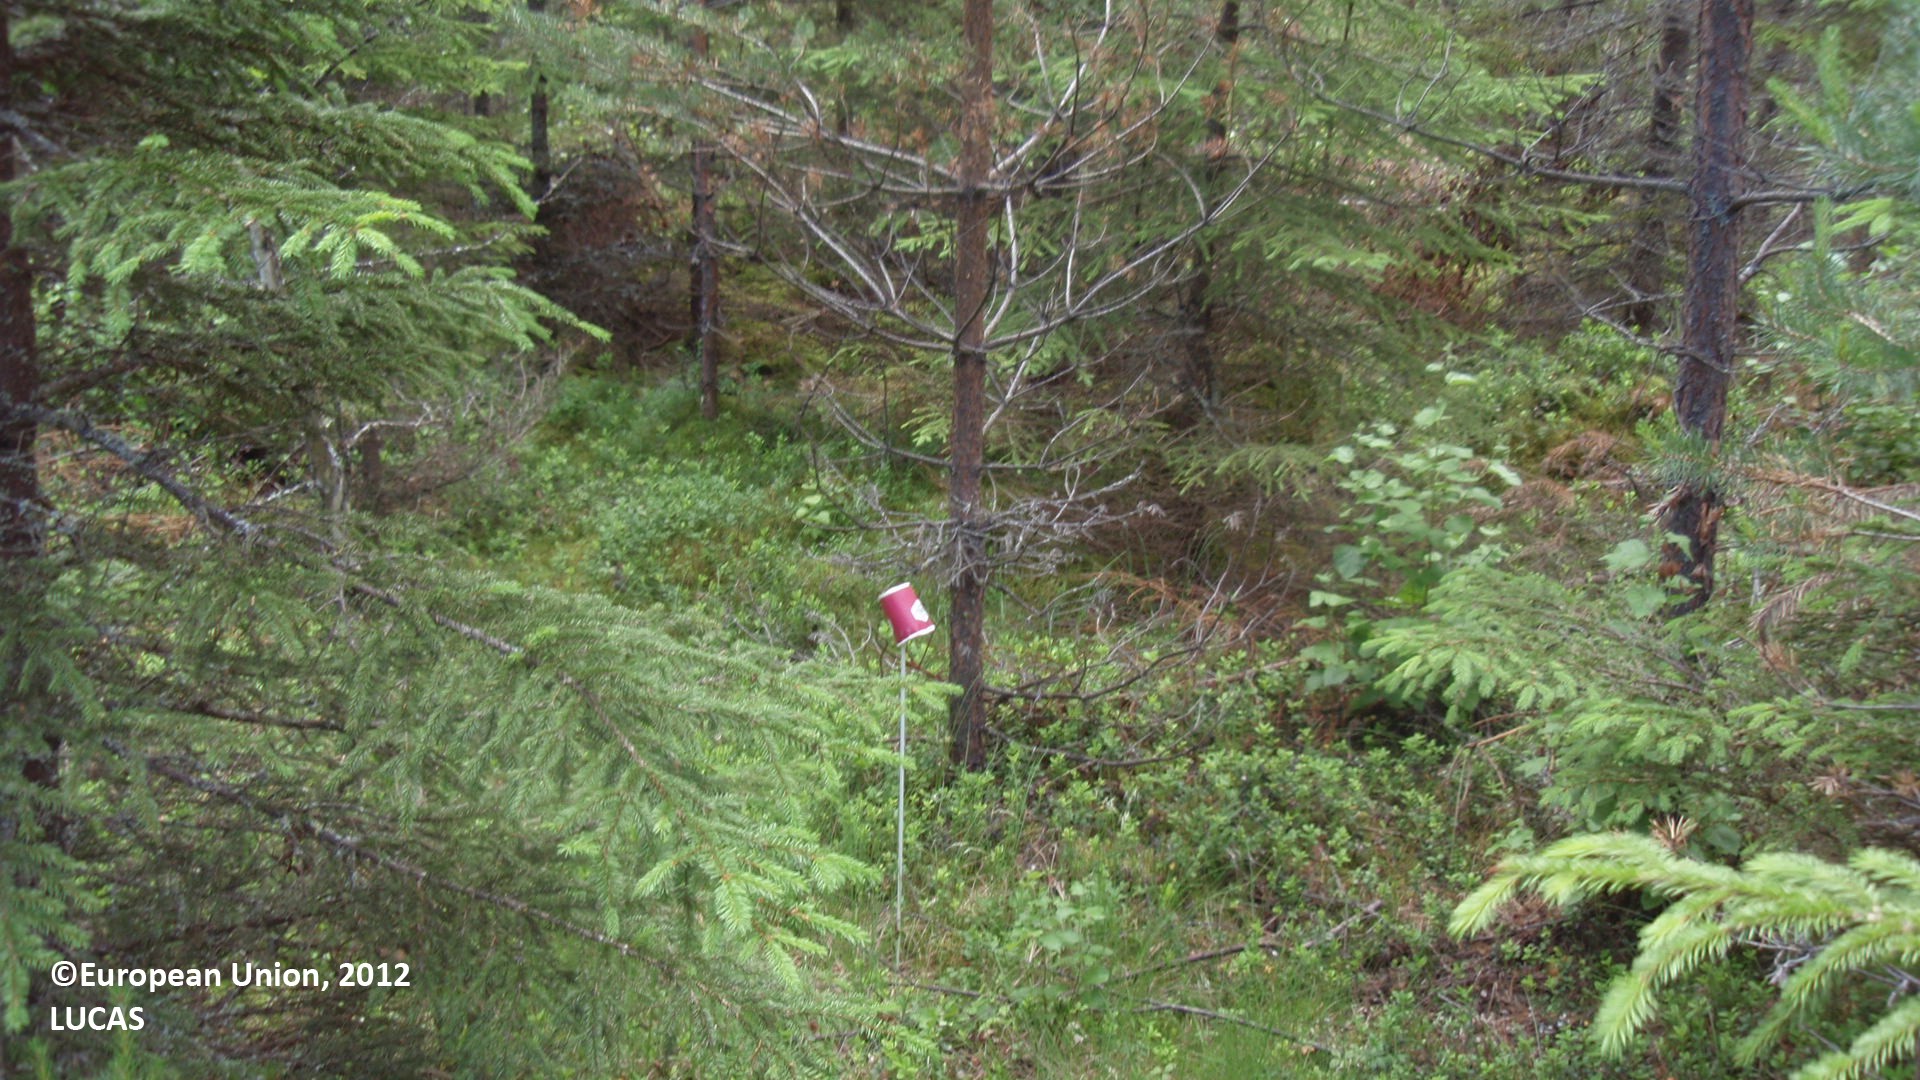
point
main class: Woodland
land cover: Spruce dominated coniferous woodland
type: boreal forest
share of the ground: 50 - 75 %
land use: Forestry
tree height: < 5 m
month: July
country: FI
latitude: 61.6692
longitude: 28.0836
